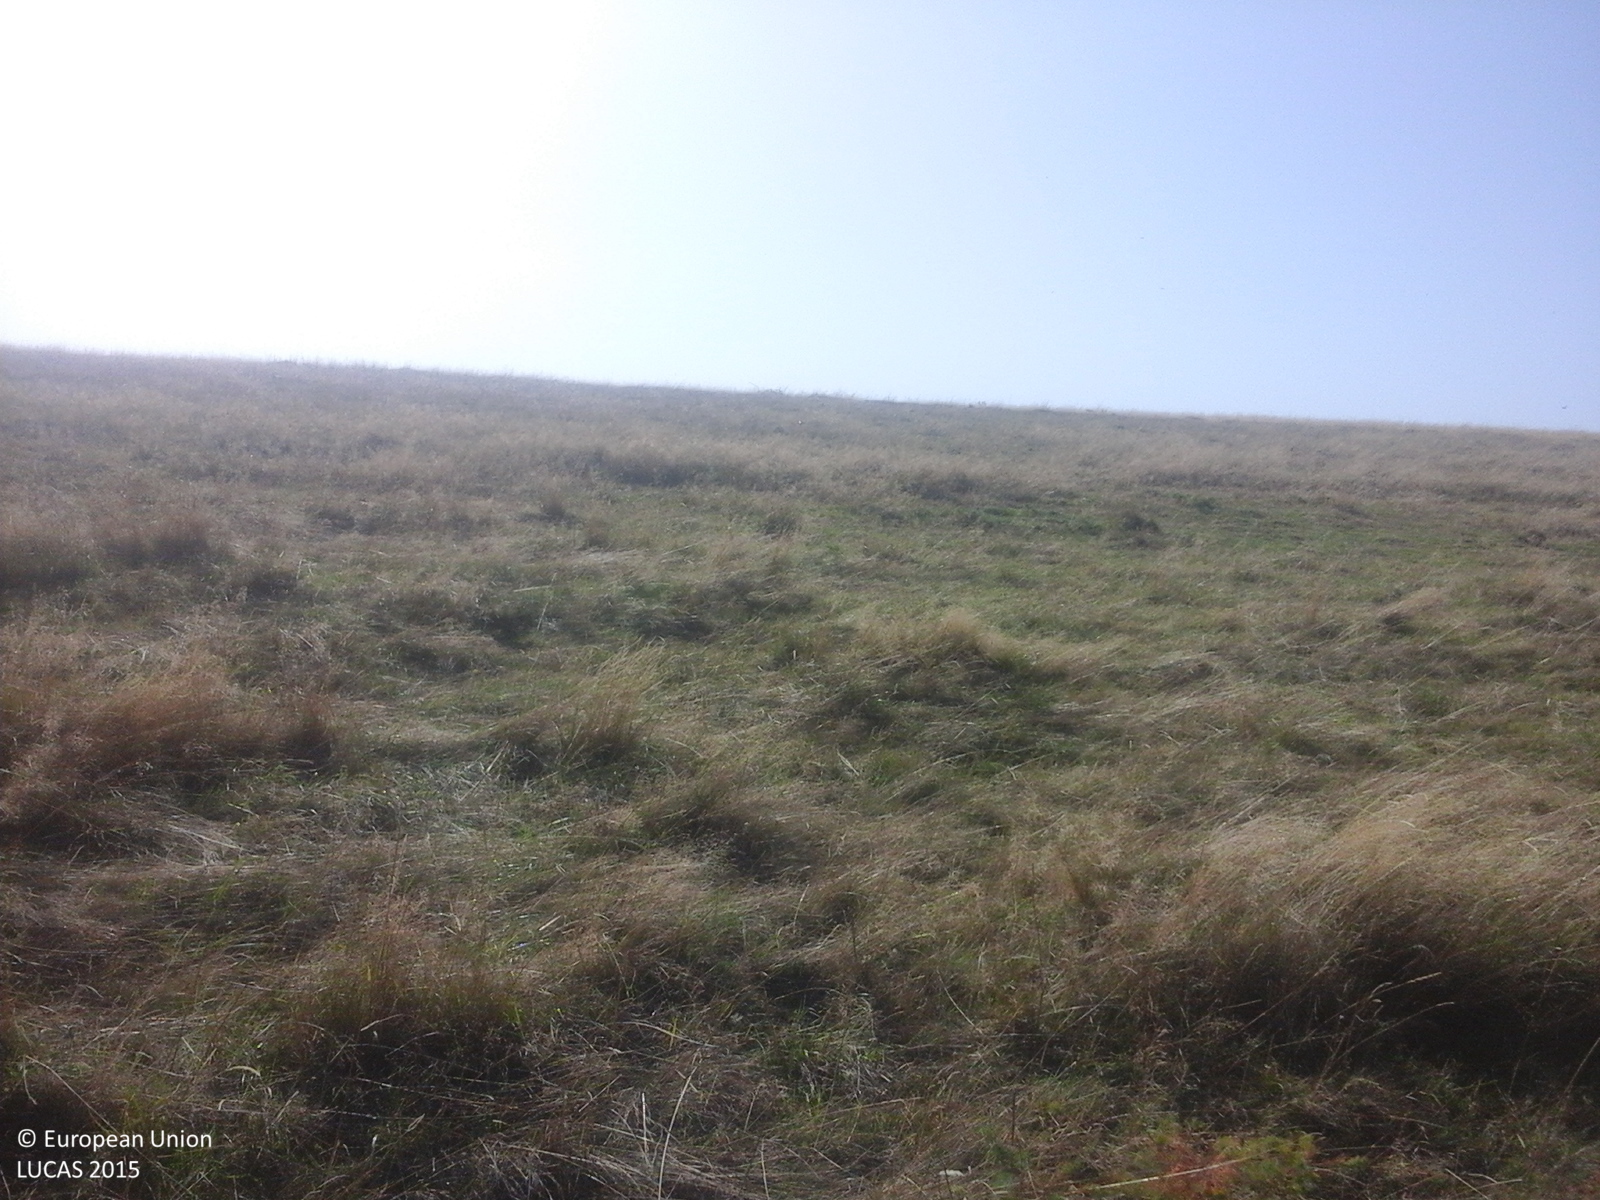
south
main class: Grassland
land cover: Grassland without tree/shrub cover
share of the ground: > 75 %
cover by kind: herbaceous plants 100 %
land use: Agriculture (excluding fallow land and kitchen gardens)
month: September
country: RO
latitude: 46.8696
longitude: 24.4004
